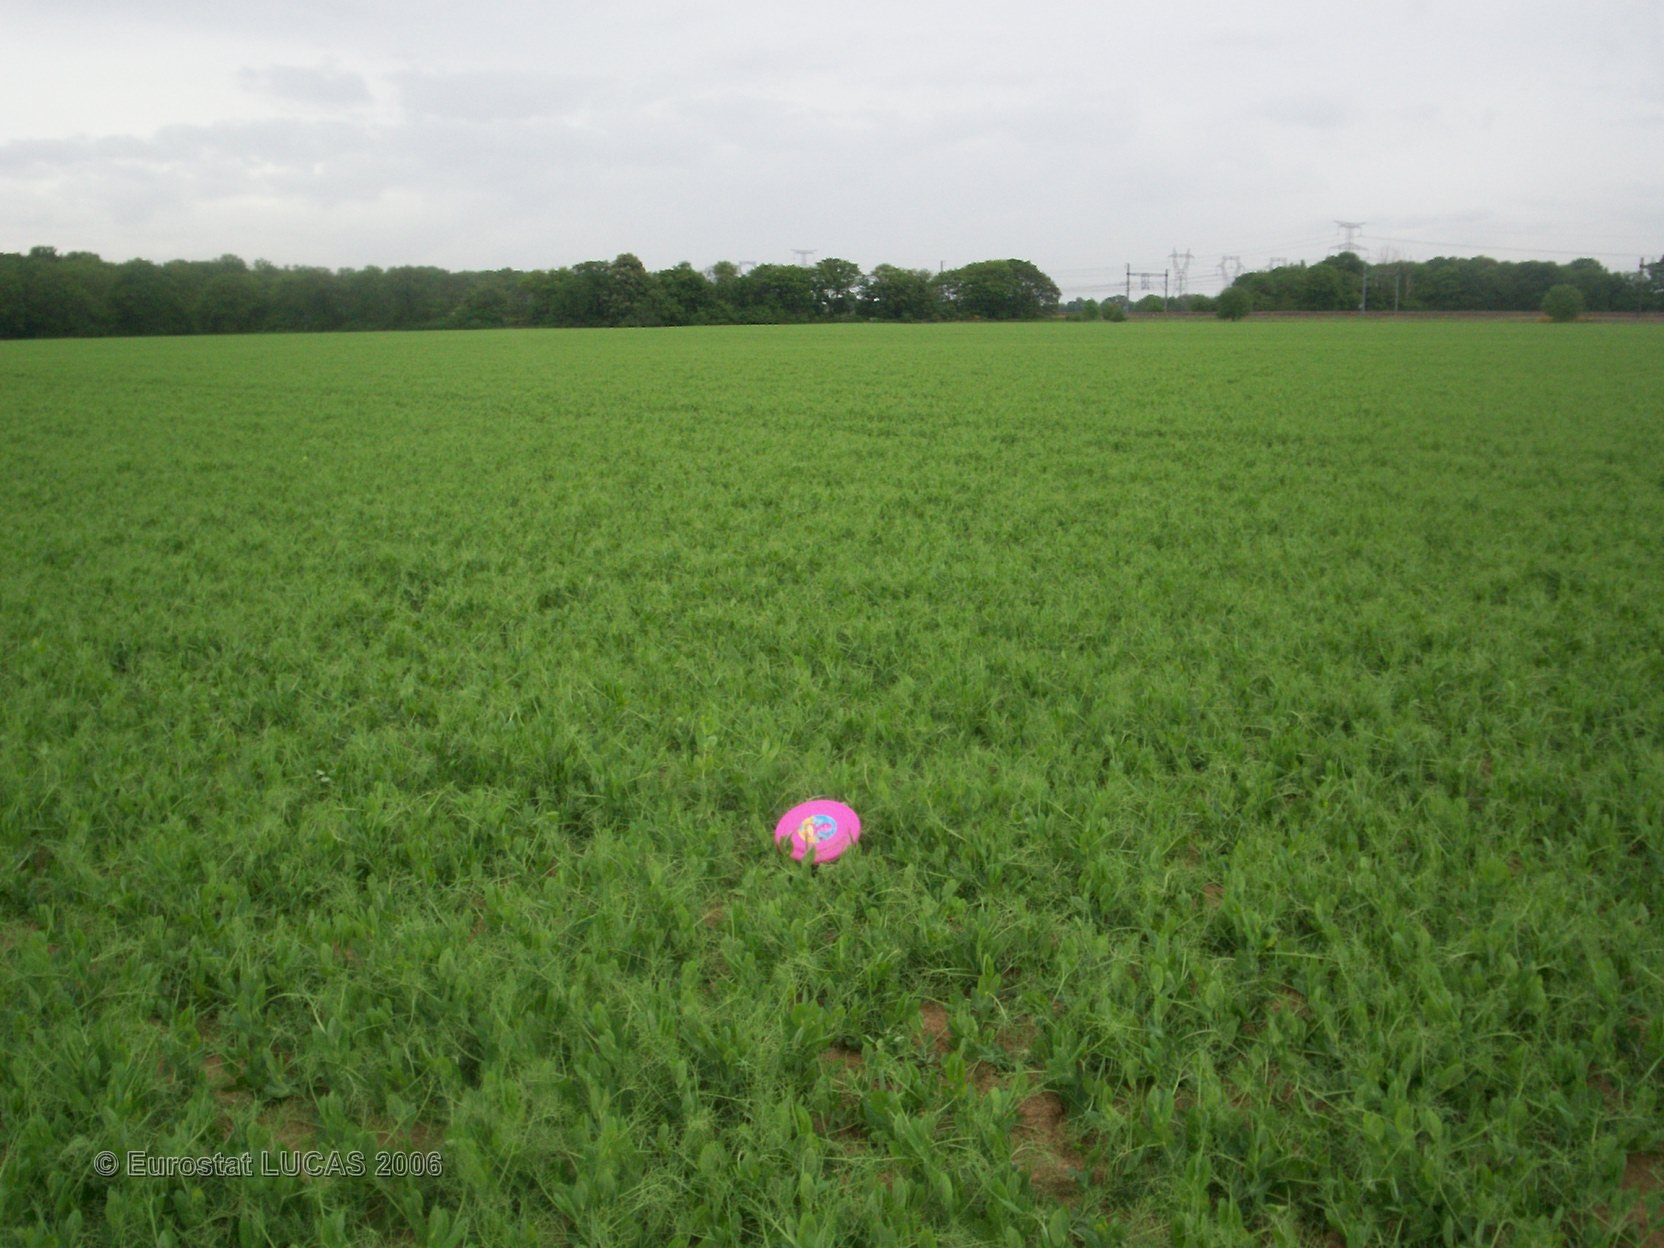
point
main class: Cropland
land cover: Dry pulses
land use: Agriculture (excluding fallow land and kitchen gardens)
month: May
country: FR
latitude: 48.6695
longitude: 2.7254
